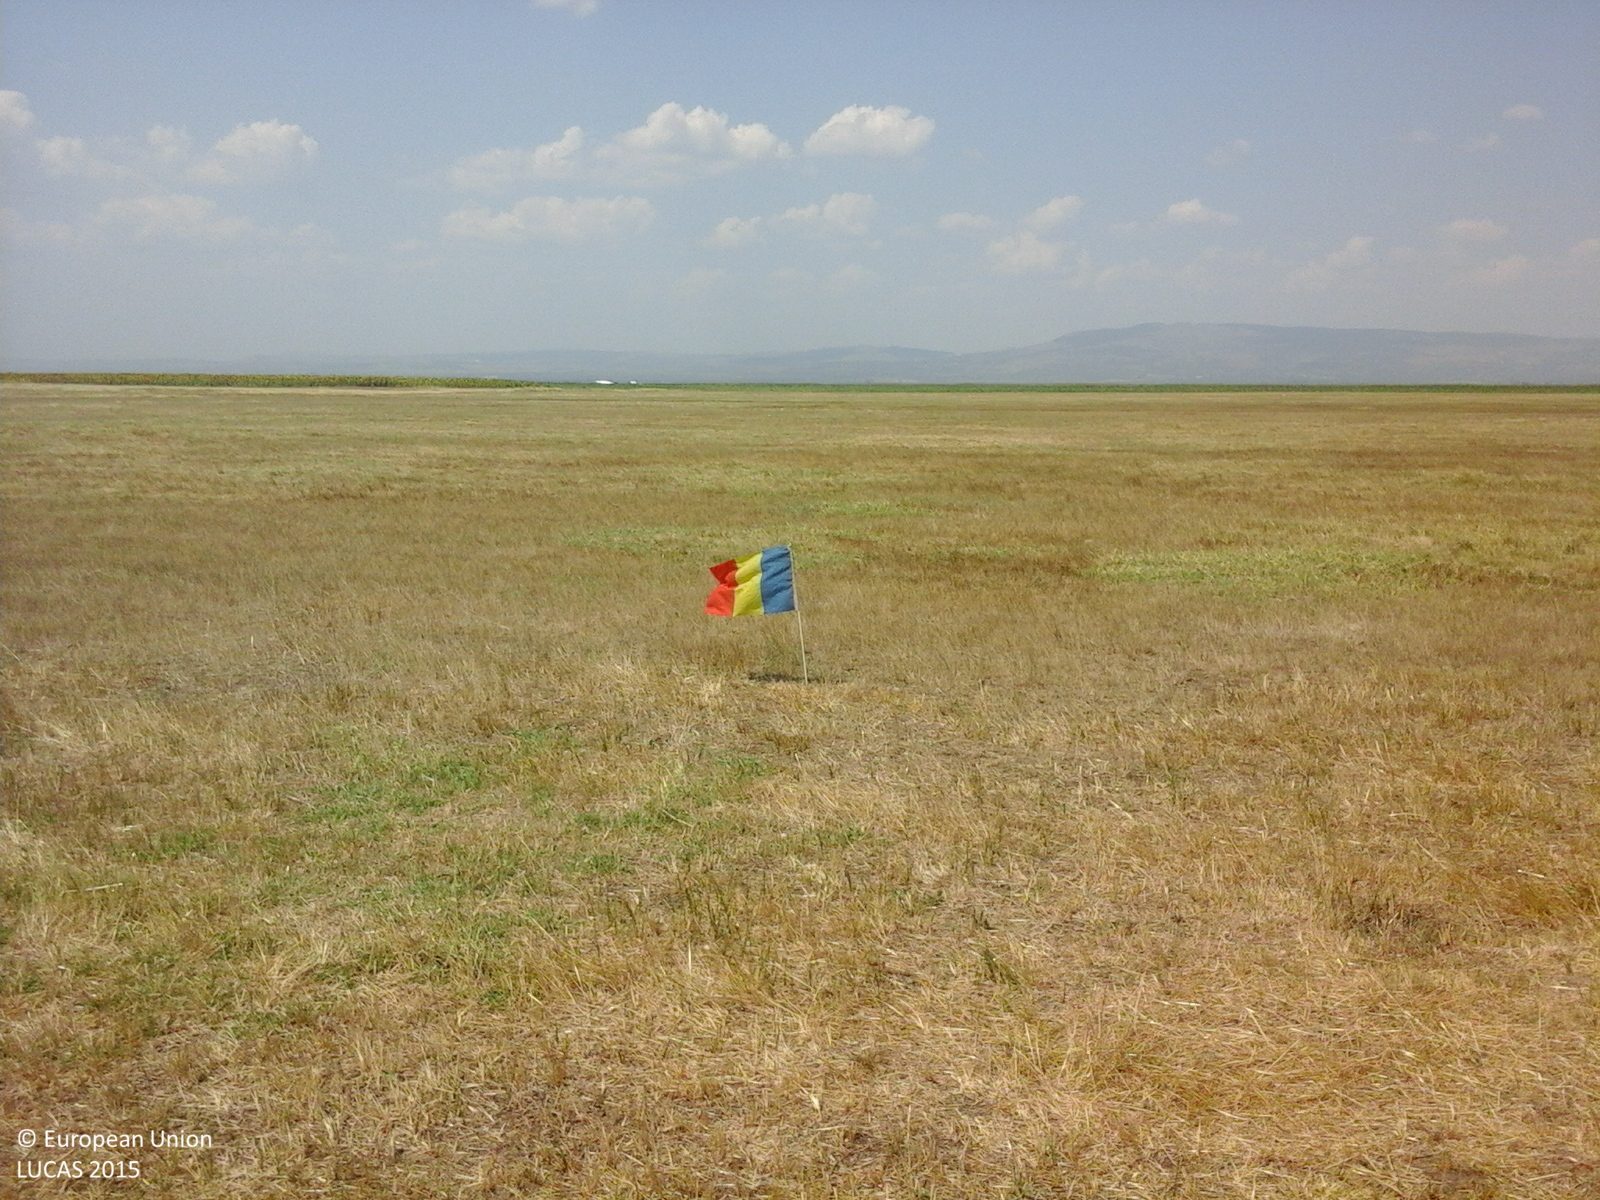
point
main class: Grassland
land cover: Grassland without tree/shrub cover
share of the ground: > 75 %
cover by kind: herbaceous plants 100 %
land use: Agriculture (excluding fallow land and kitchen gardens)
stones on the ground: < 10 %
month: August
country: RO
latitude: 44.9971
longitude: 26.6536
